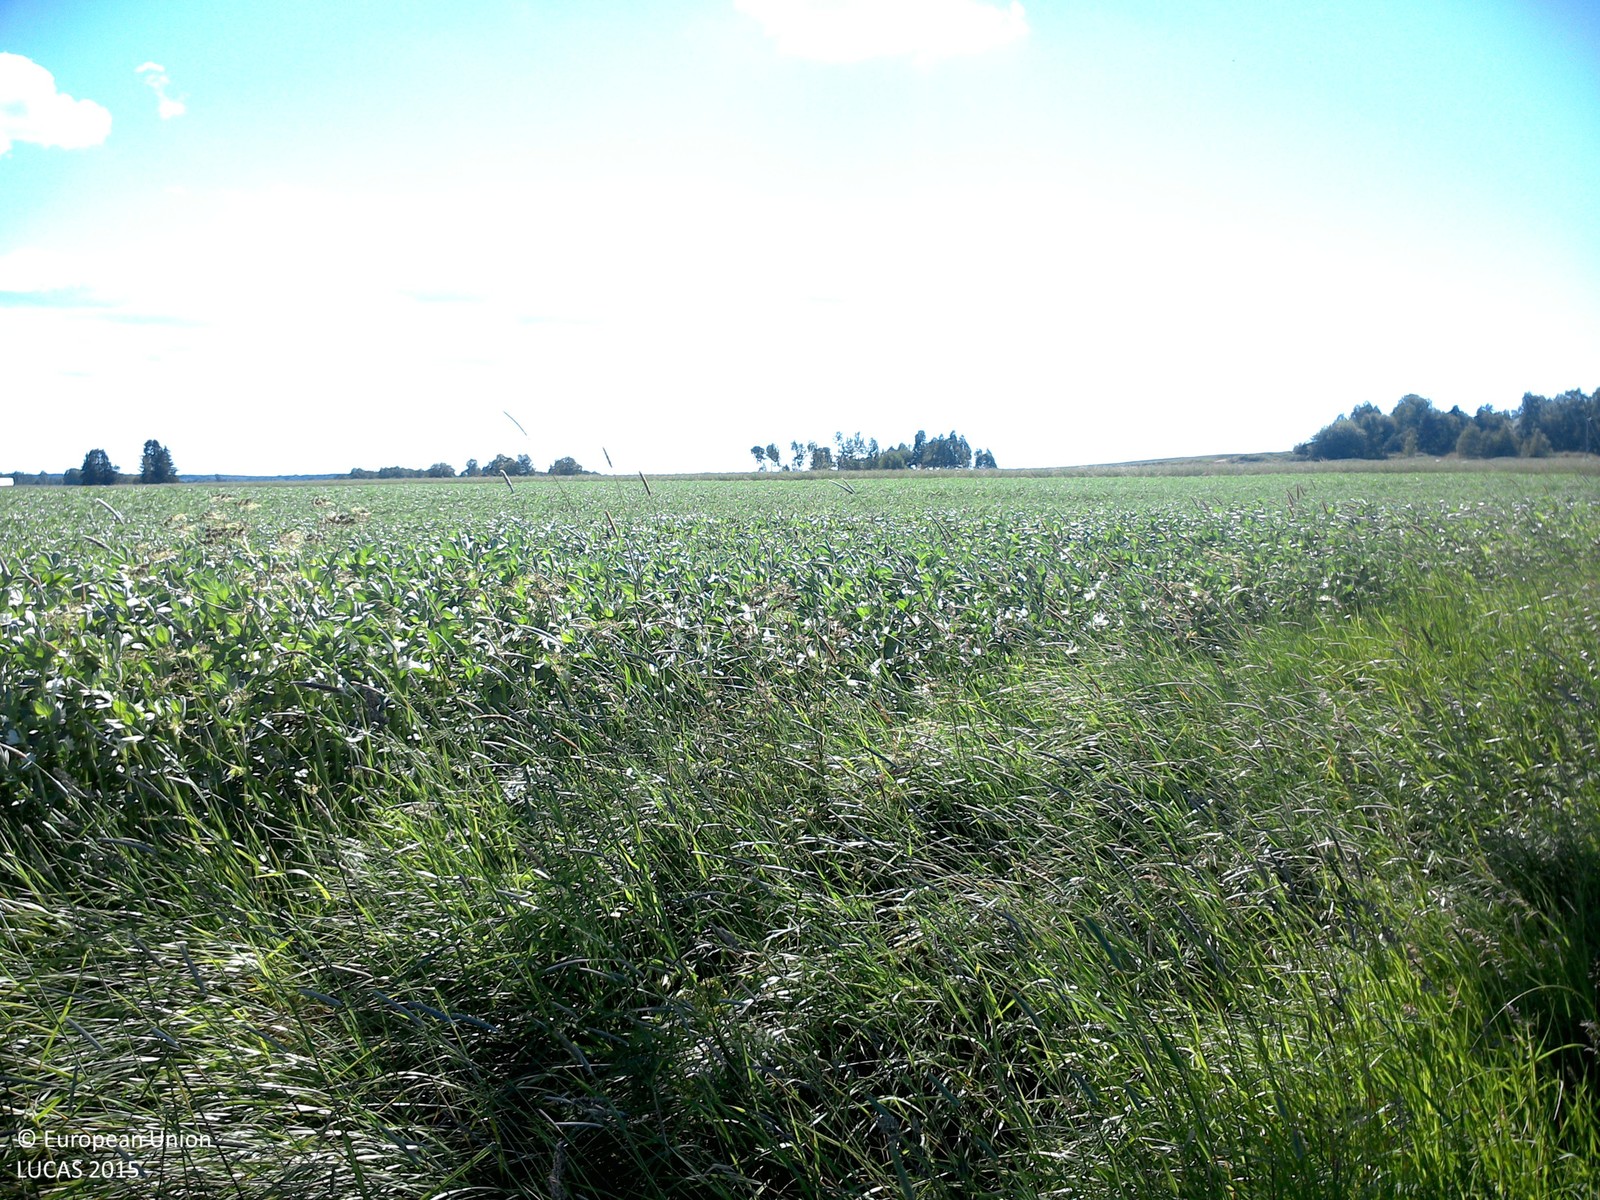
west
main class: Cropland
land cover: Dry pulses
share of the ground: > 75 %
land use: Agriculture (excluding fallow land and kitchen gardens)
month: July
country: SE
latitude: 58.3092
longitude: 15.4047
